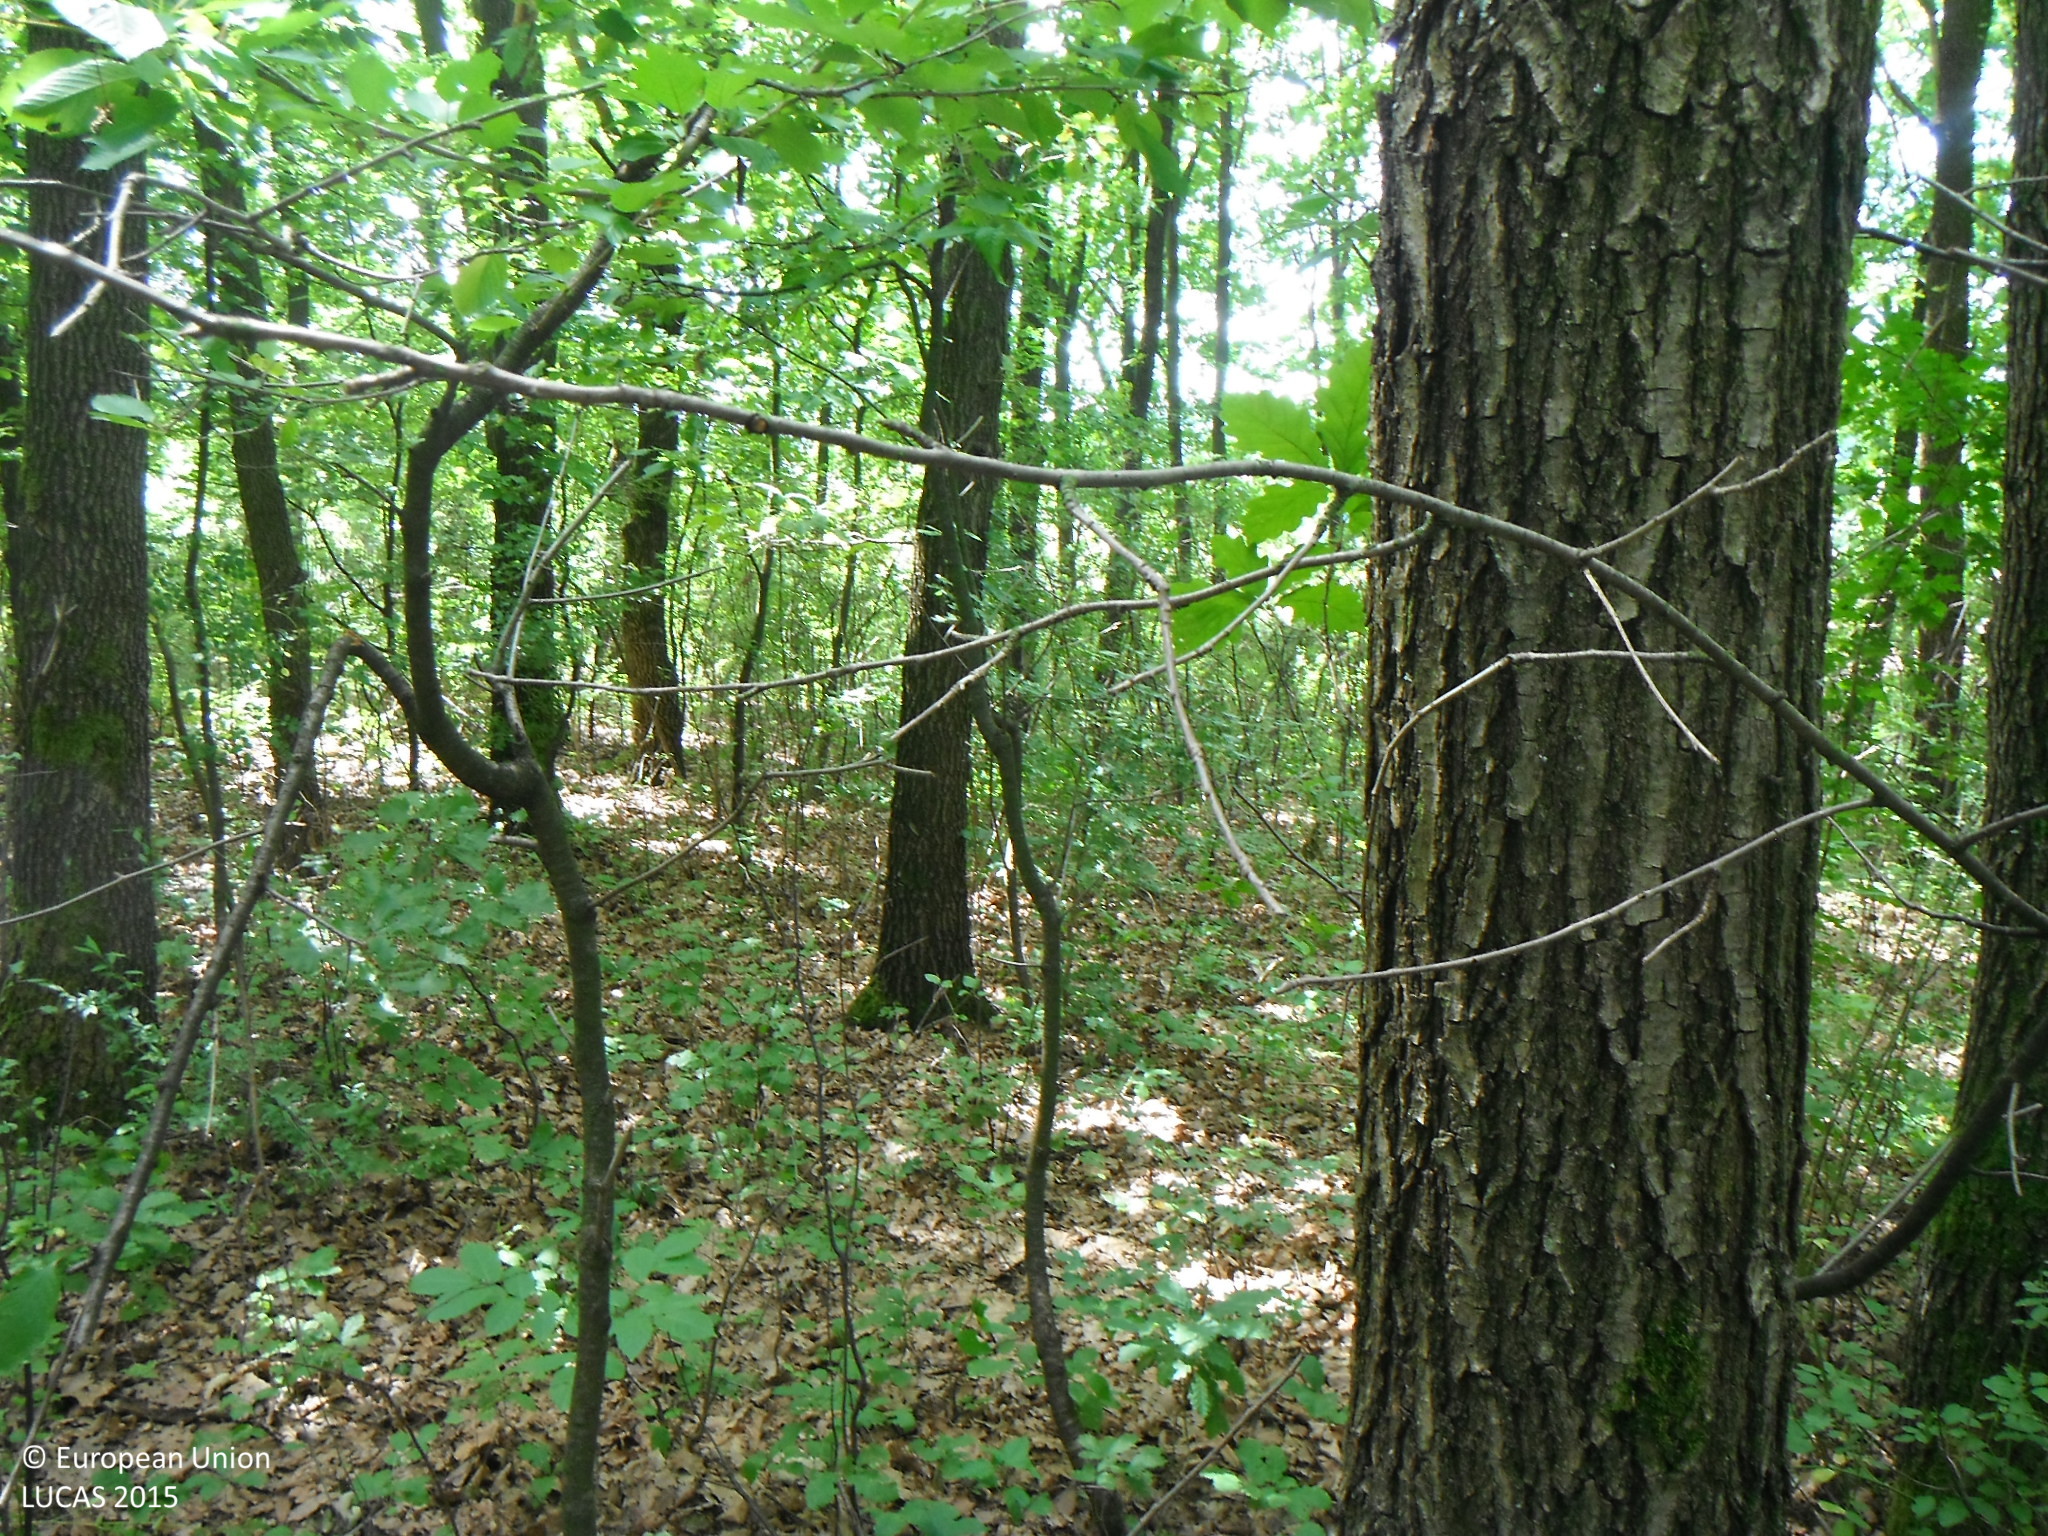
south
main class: Woodland
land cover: Broadleaved woodland
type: mesophytic deciduous forest
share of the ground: > 75 %
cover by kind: broadleaved forest trees 90 %, shrubs 10 %
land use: Forestry
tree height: > 5 m
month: July
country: SK
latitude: 48.1640
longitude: 19.8284
